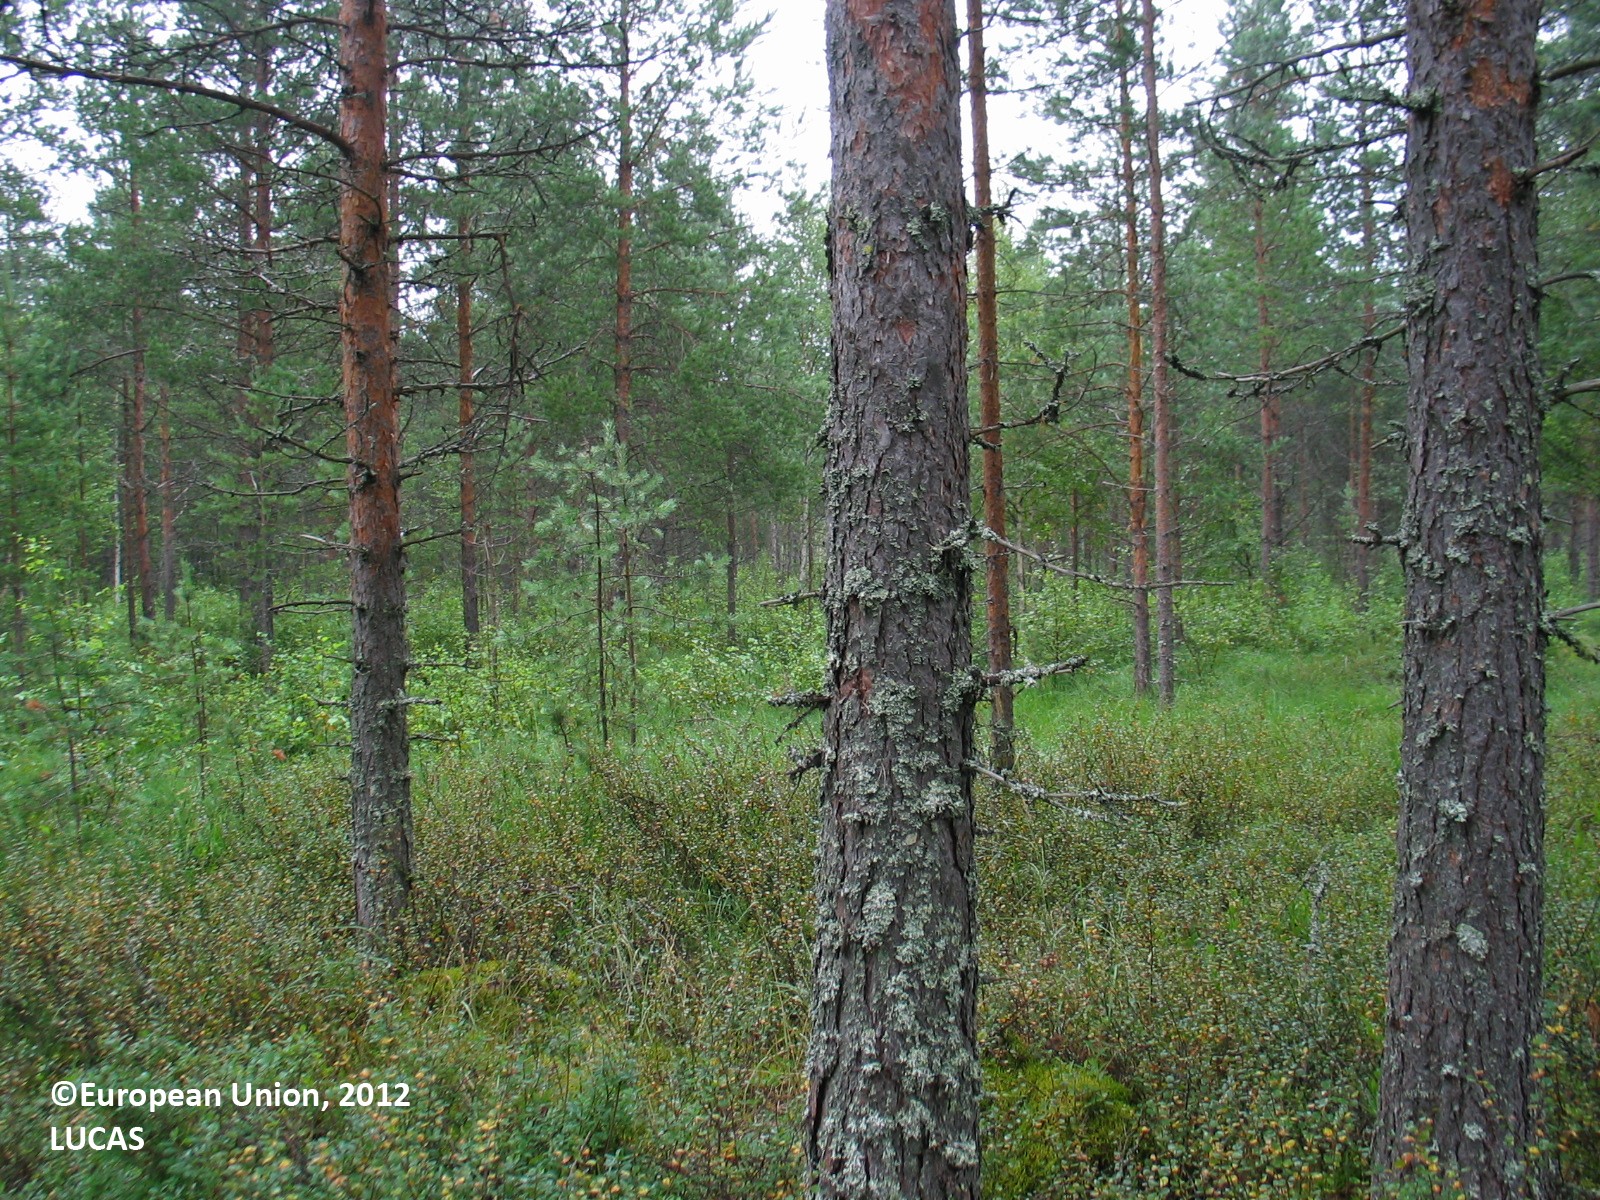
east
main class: Woodland
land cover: Pine dominated mixed woodland
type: mire and swamp forests
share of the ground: 25 - 50 %
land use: Forestry
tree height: > 5 m
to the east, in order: Pine dominated mixed woodland; Ditches and canals; Other mixed woodland; Shrubland with sparse tree cover; Other mixed woodland; Ditches and canals; Pine dominated coniferous woodland
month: August
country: FI
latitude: 64.5969
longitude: 25.9997
